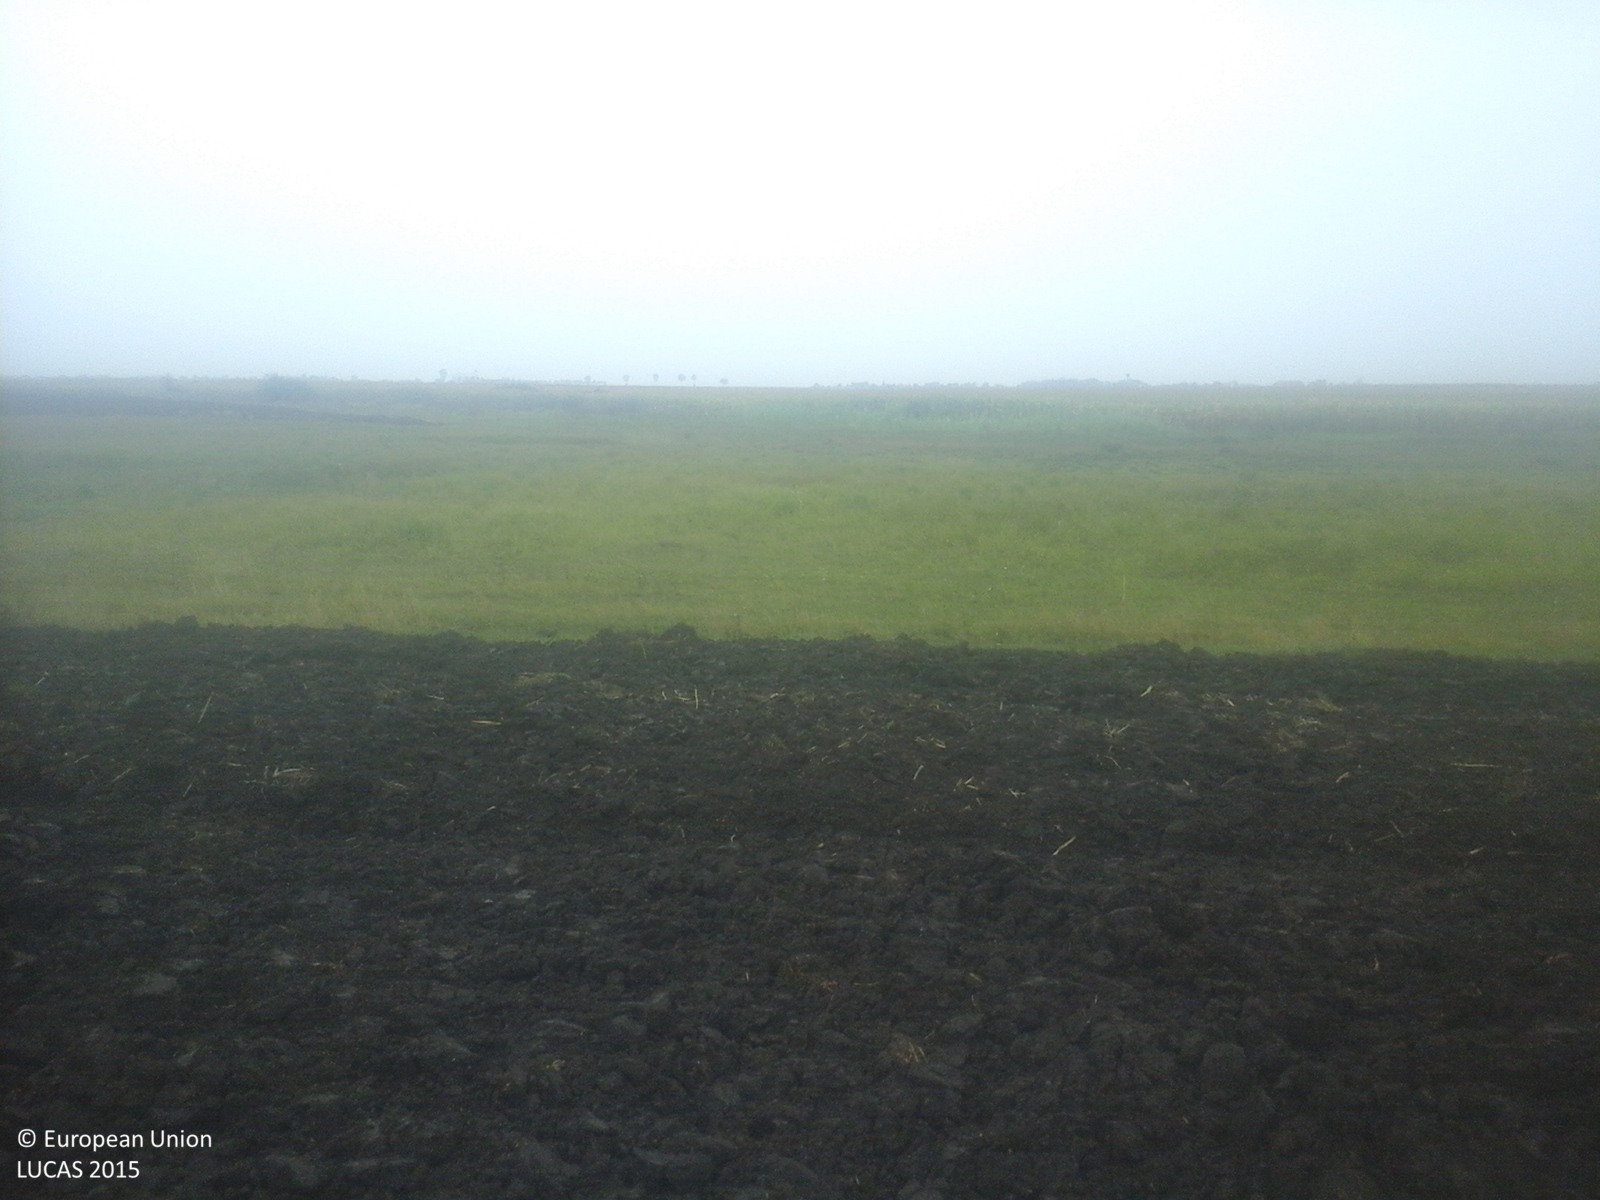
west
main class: Cropland
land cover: Rape and turnip rape
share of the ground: < 10 %
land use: Agriculture (excluding fallow land and kitchen gardens)
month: September
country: RO
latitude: 47.5358
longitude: 22.4236
